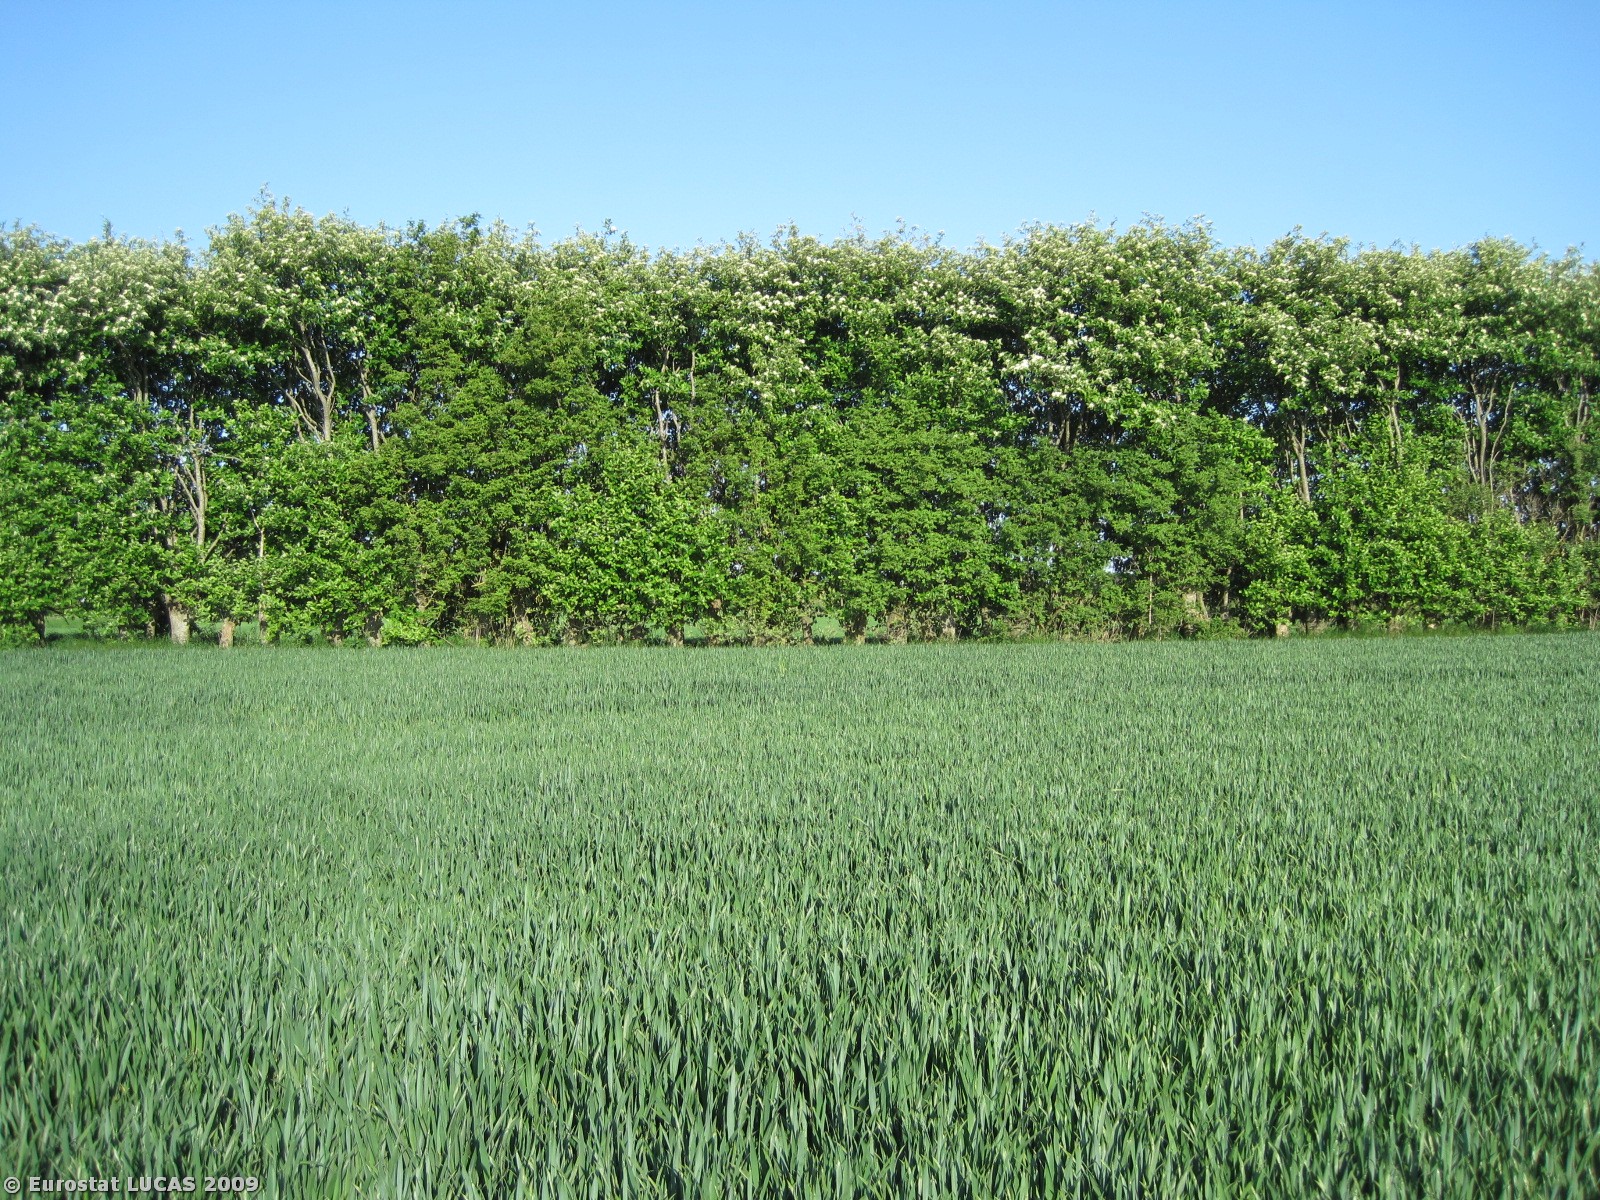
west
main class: Cropland
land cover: Common wheat
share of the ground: > 75 %
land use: Agriculture (excluding fallow land and kitchen gardens)
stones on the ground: < 10 %
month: May
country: DK
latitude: 56.6190
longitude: 10.2116
